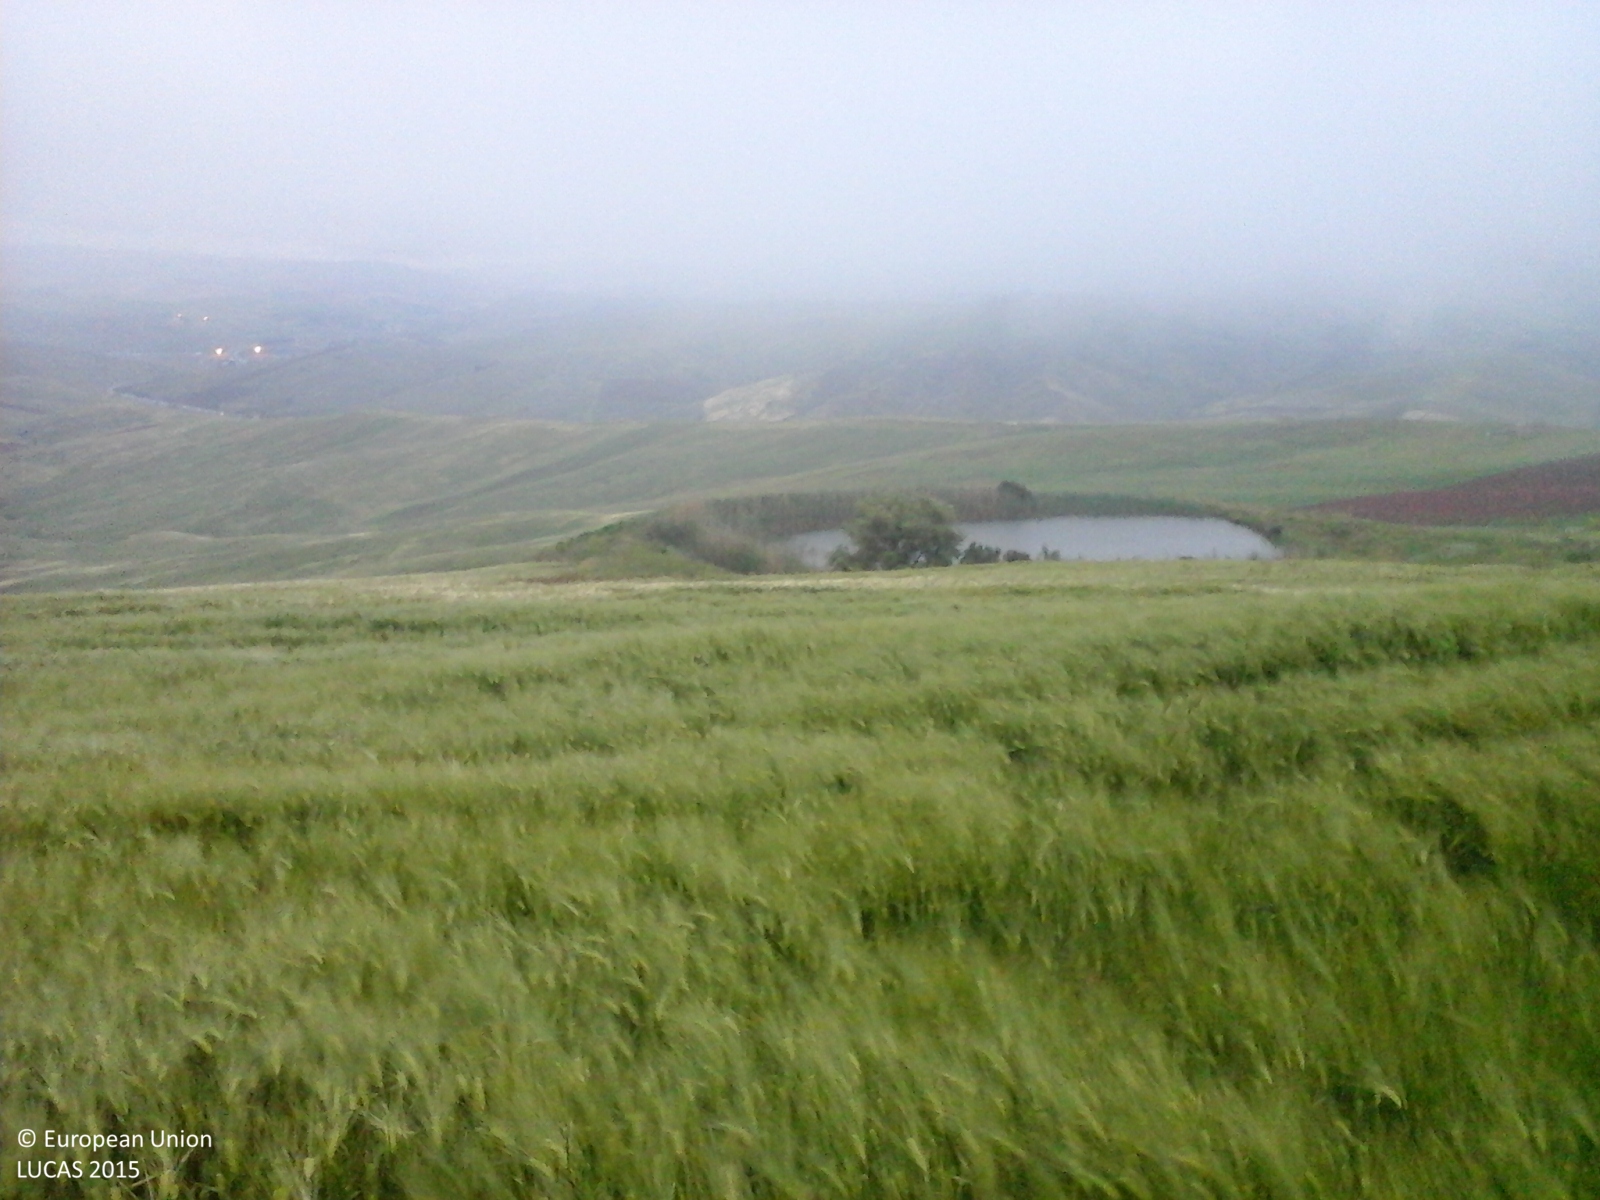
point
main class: Cropland
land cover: Barley
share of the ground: > 75 %
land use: Agriculture (excluding fallow land and kitchen gardens)
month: May
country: IT
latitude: 37.7542
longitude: 14.0004
